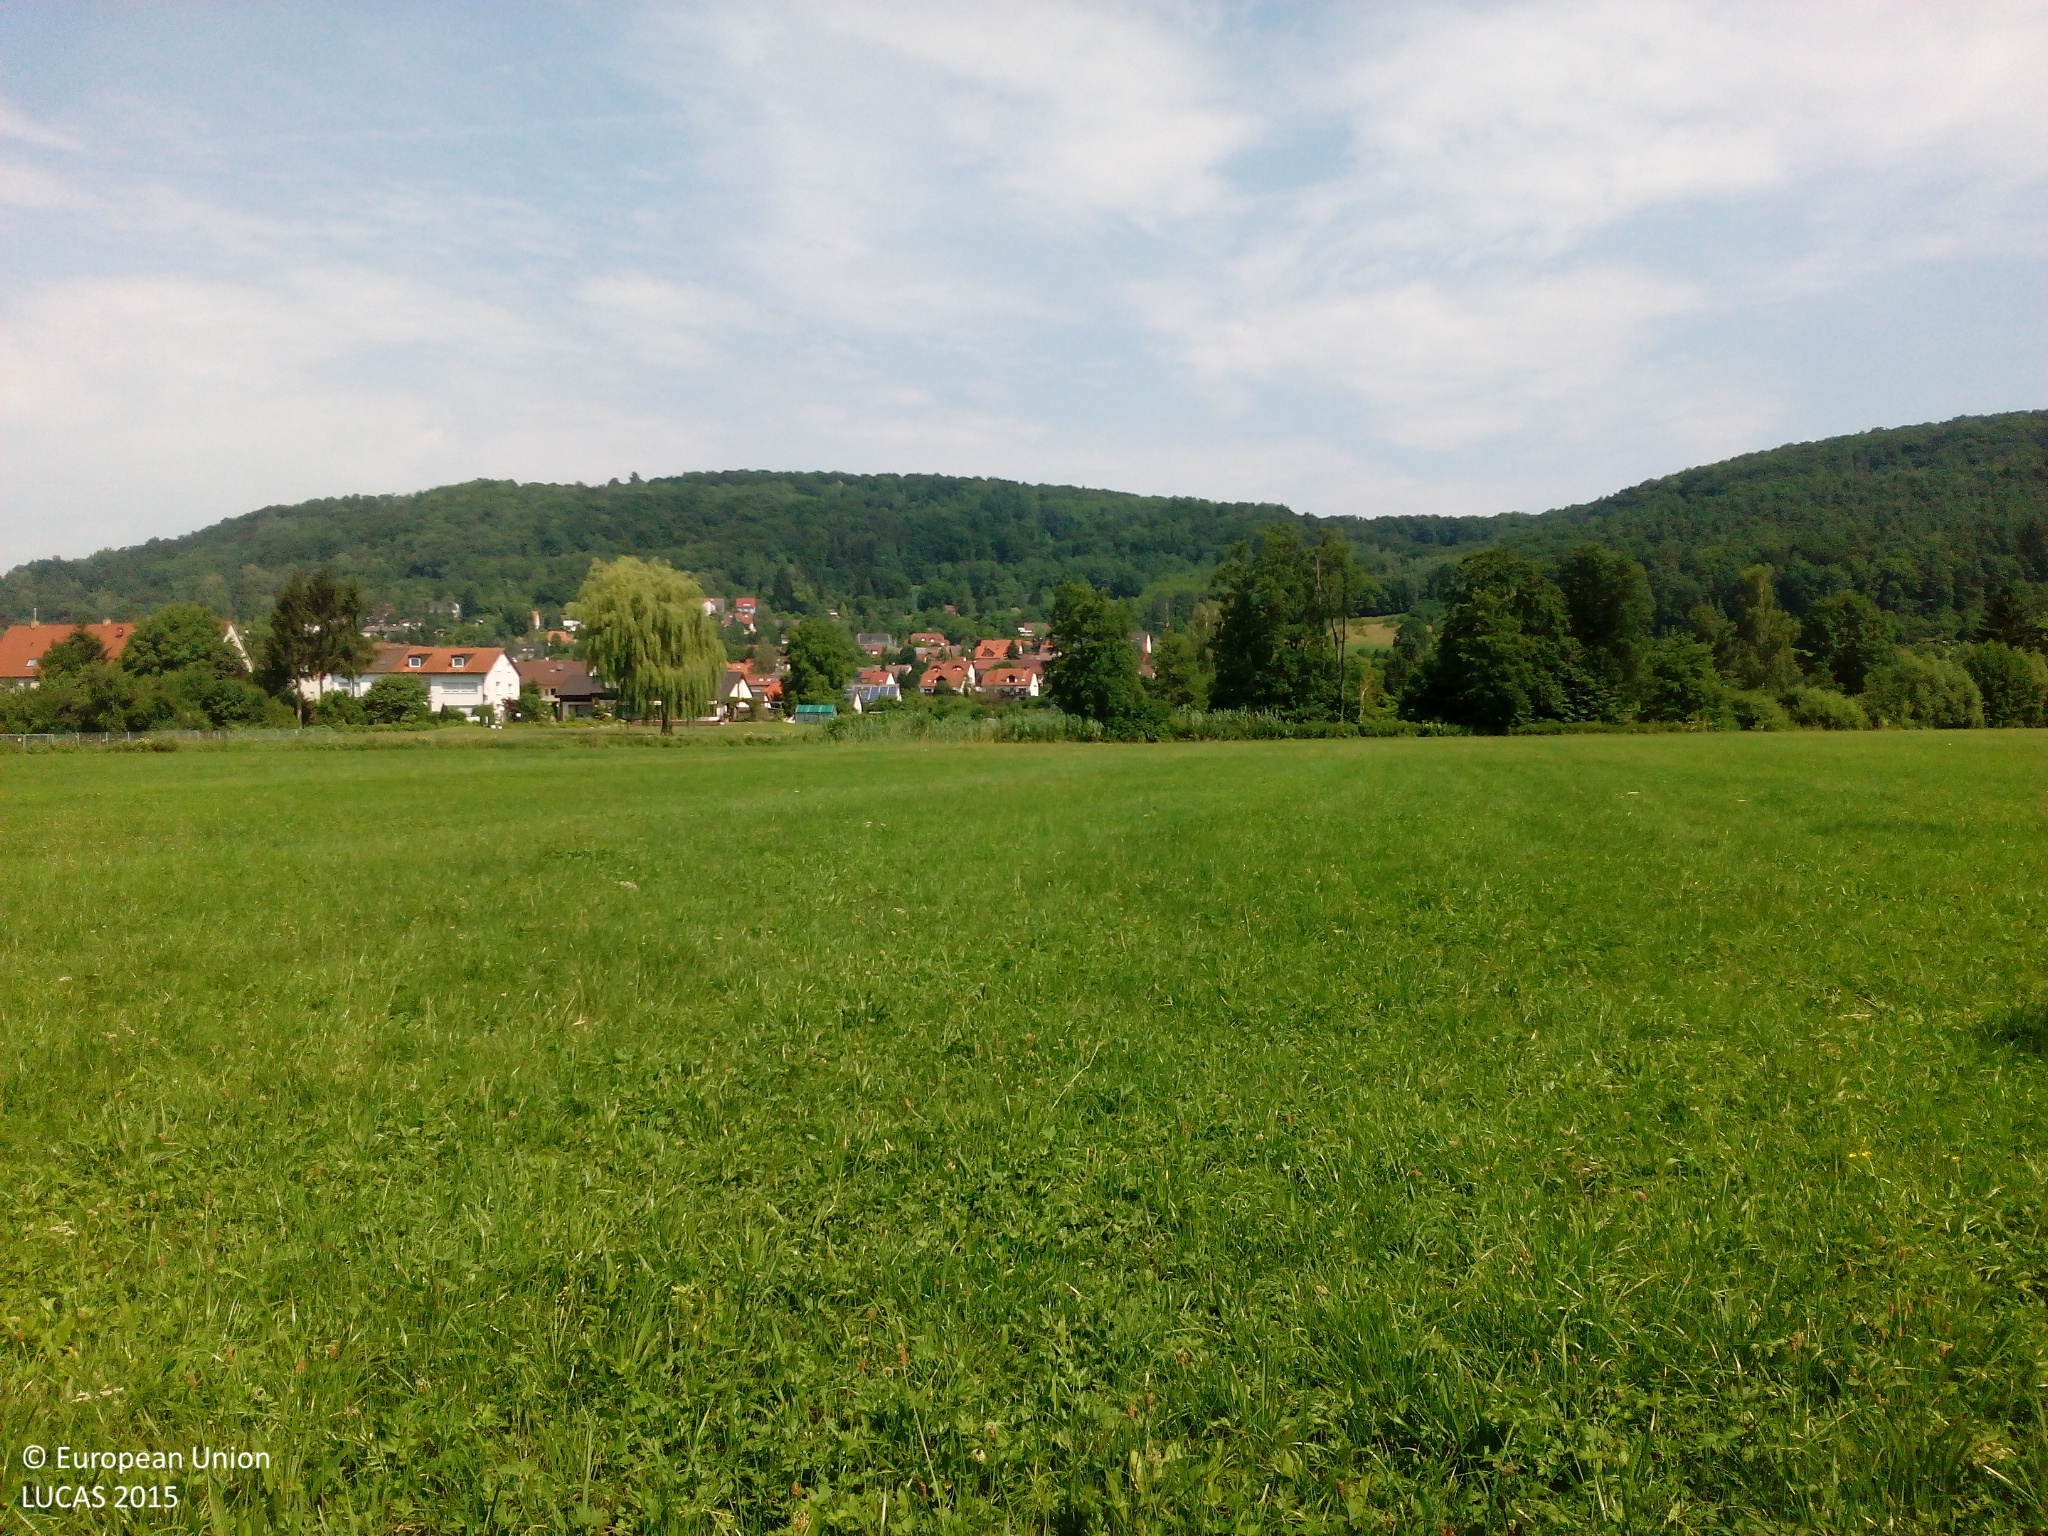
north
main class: Grassland
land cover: Grassland without tree/shrub cover
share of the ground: > 75 %
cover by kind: herbaceous plants 100 %
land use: Agriculture (excluding fallow land and kitchen gardens)
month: July
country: DE
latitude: 49.5095
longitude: 11.4497
